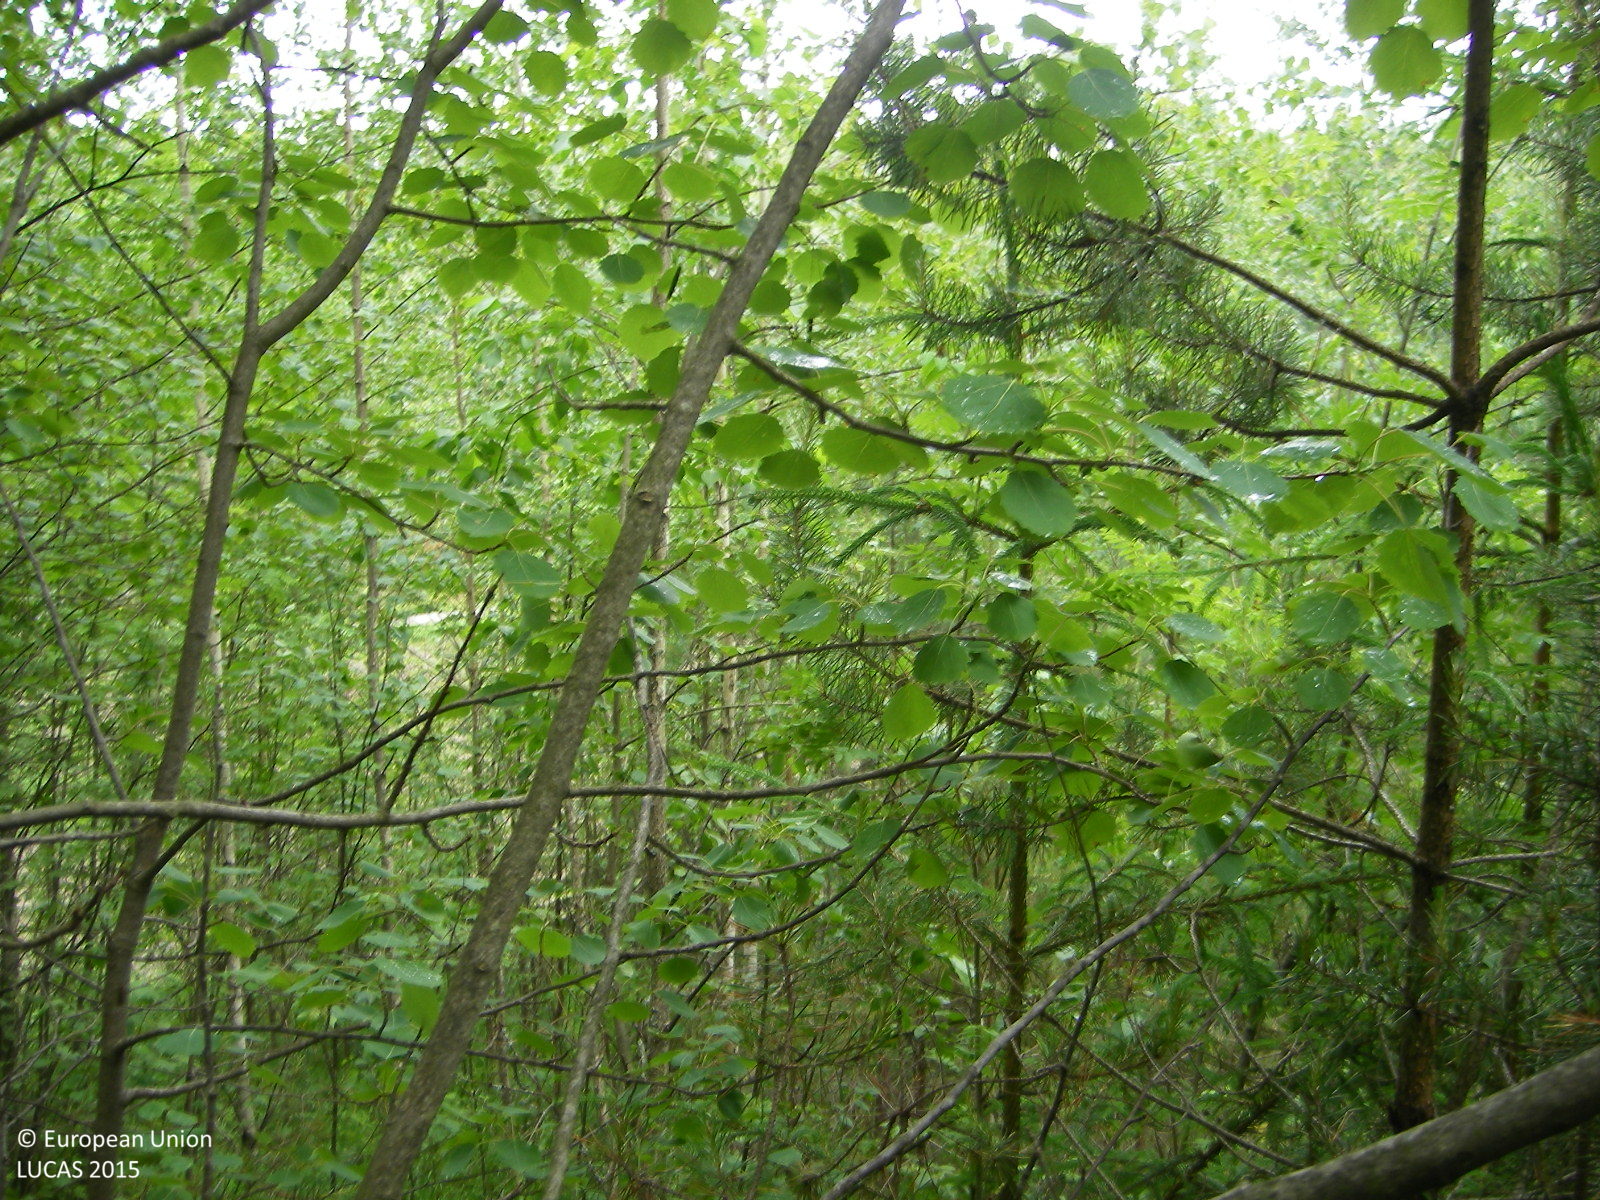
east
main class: Woodland
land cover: Broadleaved woodland
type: boreal forest
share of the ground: > 75 %
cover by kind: broadleaved forest trees 90 %, coniferous forest trees 5 %, shrubs 5 %
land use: Forestry
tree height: > 5 m
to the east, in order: Broadleaved woodland; Other bare soil; Electric lines; Grass margins; Paved roads, cycling and walking lanes; Grass margins; Ditches and canals; Broadleaved woodland; Rivers and streams; Other mixed woodland; Spruce dominated mixed woodland
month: June
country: FI
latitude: 60.3559
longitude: 23.2604
